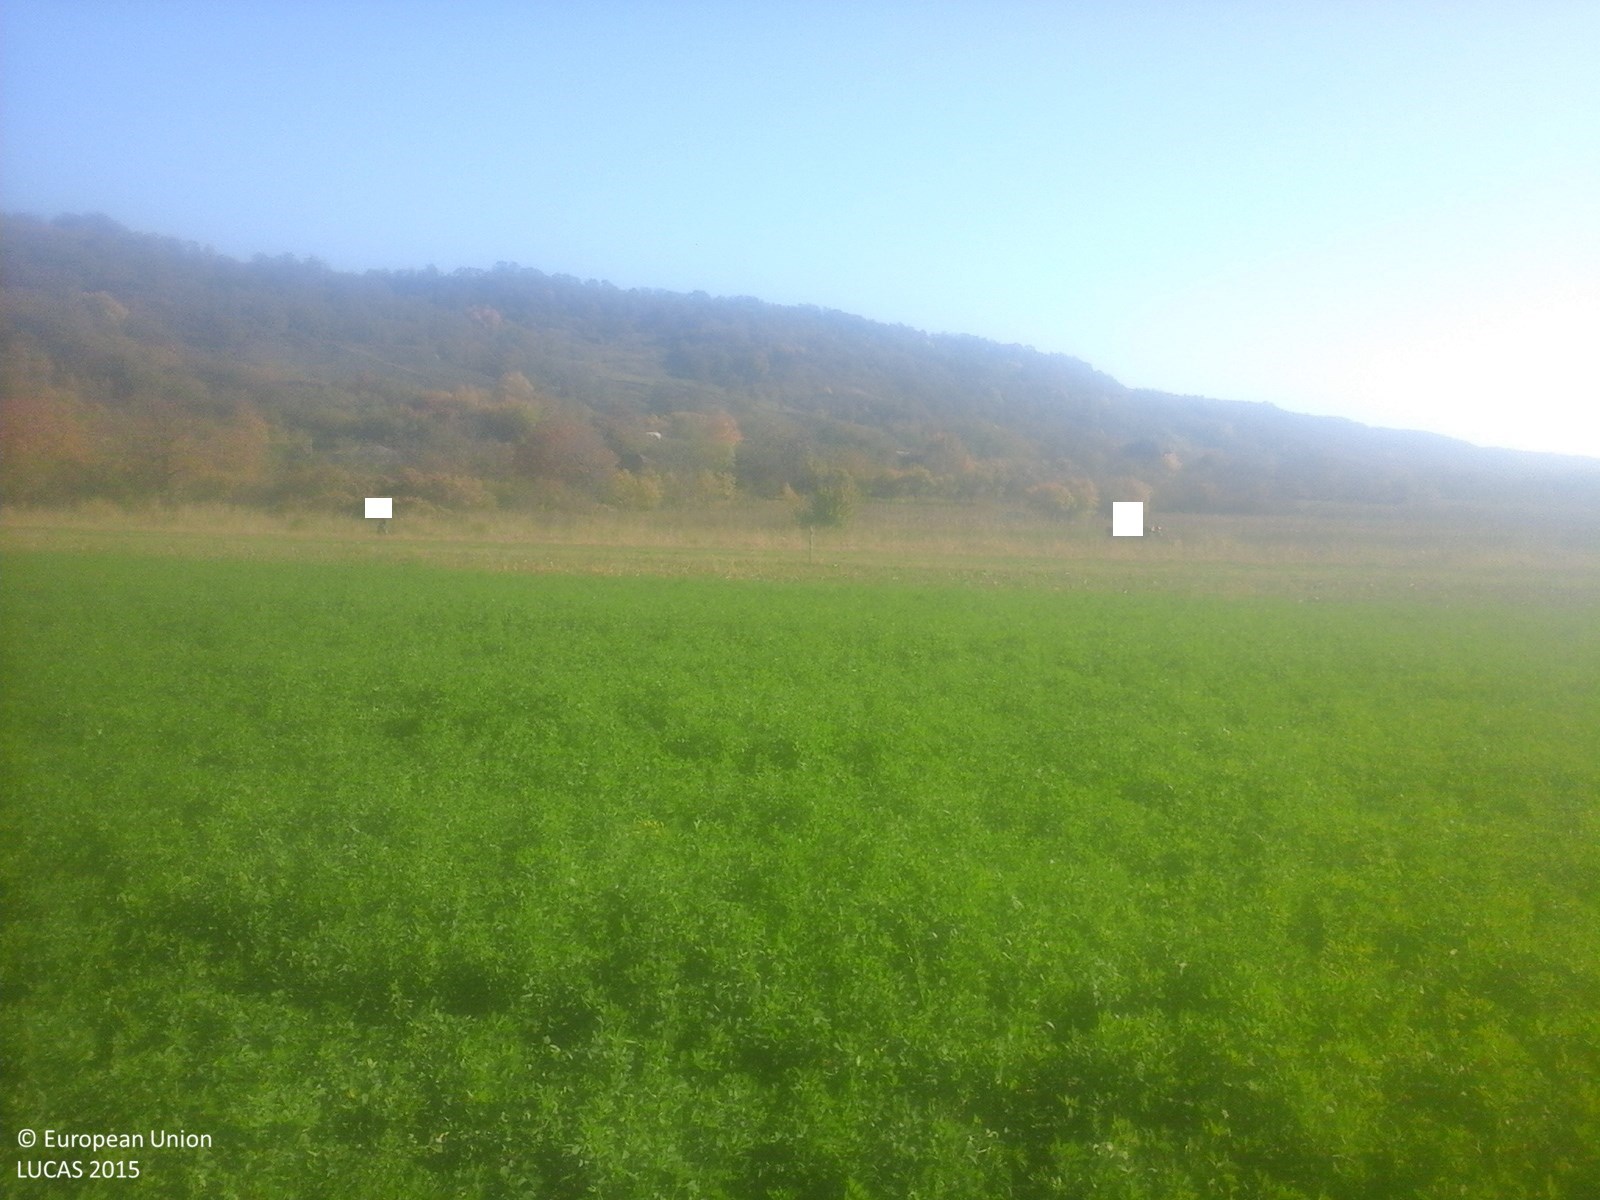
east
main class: Cropland
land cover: Lucerne
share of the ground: > 75 %
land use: Agriculture (excluding fallow land and kitchen gardens)
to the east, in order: Lucerne; Maize; Lucerne; Maize; Lucerne; Maize; Lucerne; Other leguminous and mixtures for fodder; Lucerne; Other fresh vegetables; Maize; Other leguminous and mixtures for fodder; Vineyards; Spontaneously vegetated surfaces
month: October
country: RO
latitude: 45.9205
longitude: 26.9687
